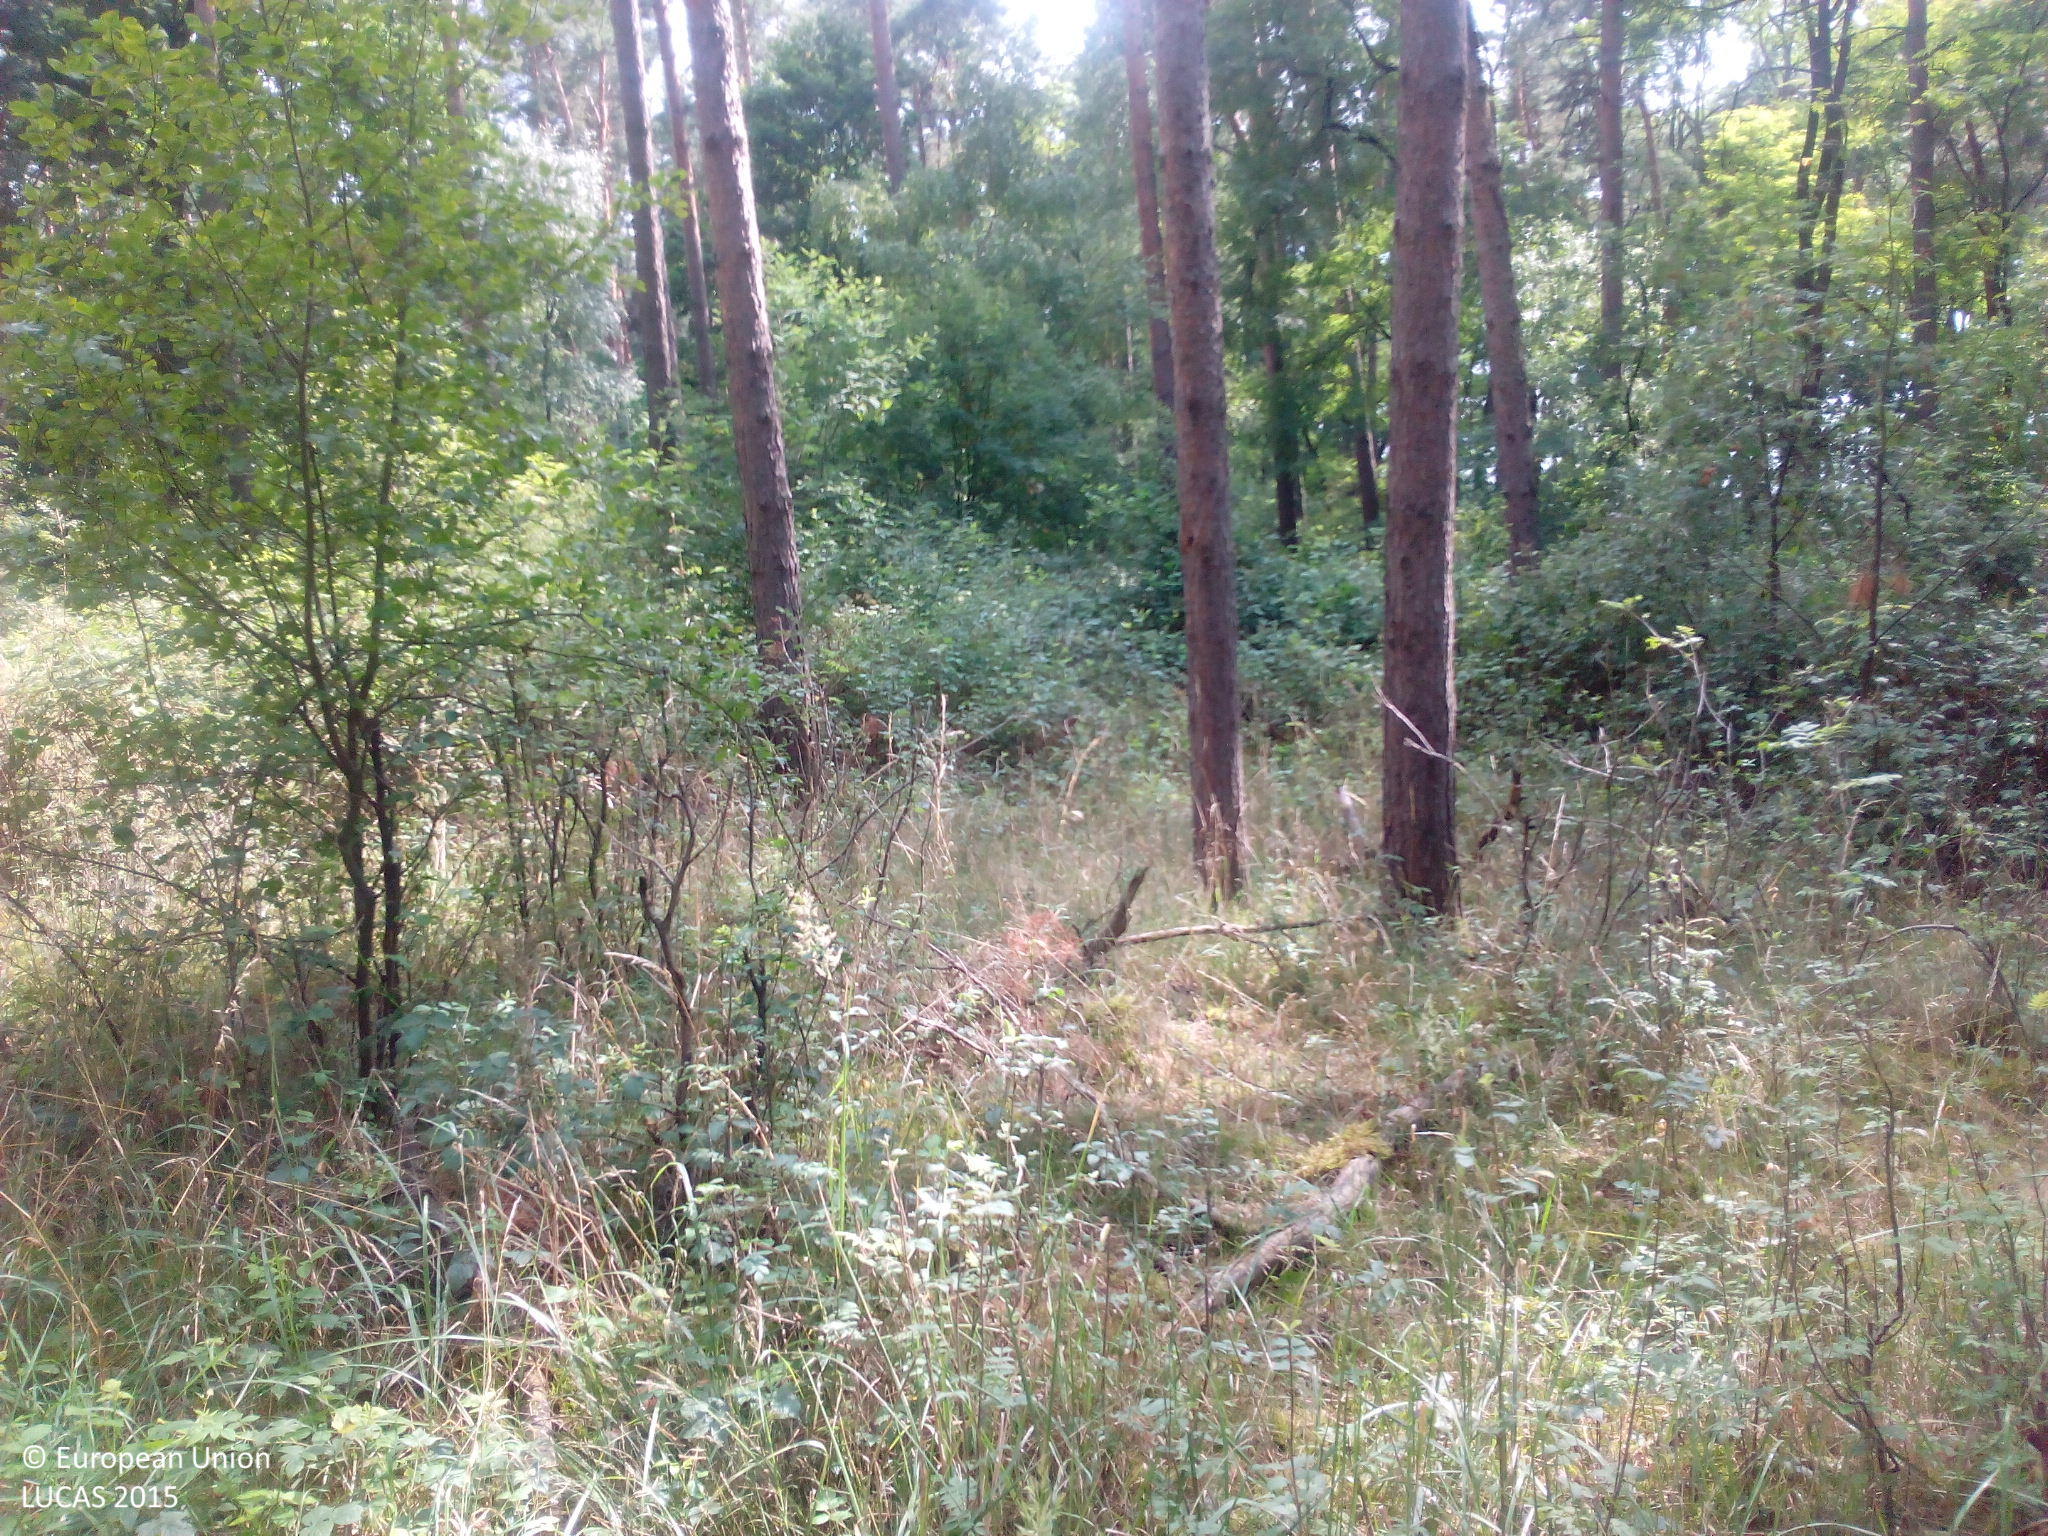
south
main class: Woodland
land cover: Pine dominated mixed woodland
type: hemiboreal forest and nemoral coniferous forest and mixed broadleaved-coniferous forest
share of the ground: > 75 %
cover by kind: coniferous forest trees 70 %, broadleaved forest trees 30 %
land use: Forestry
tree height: > 5 m
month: July
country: DE
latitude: 51.9180
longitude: 12.5732
